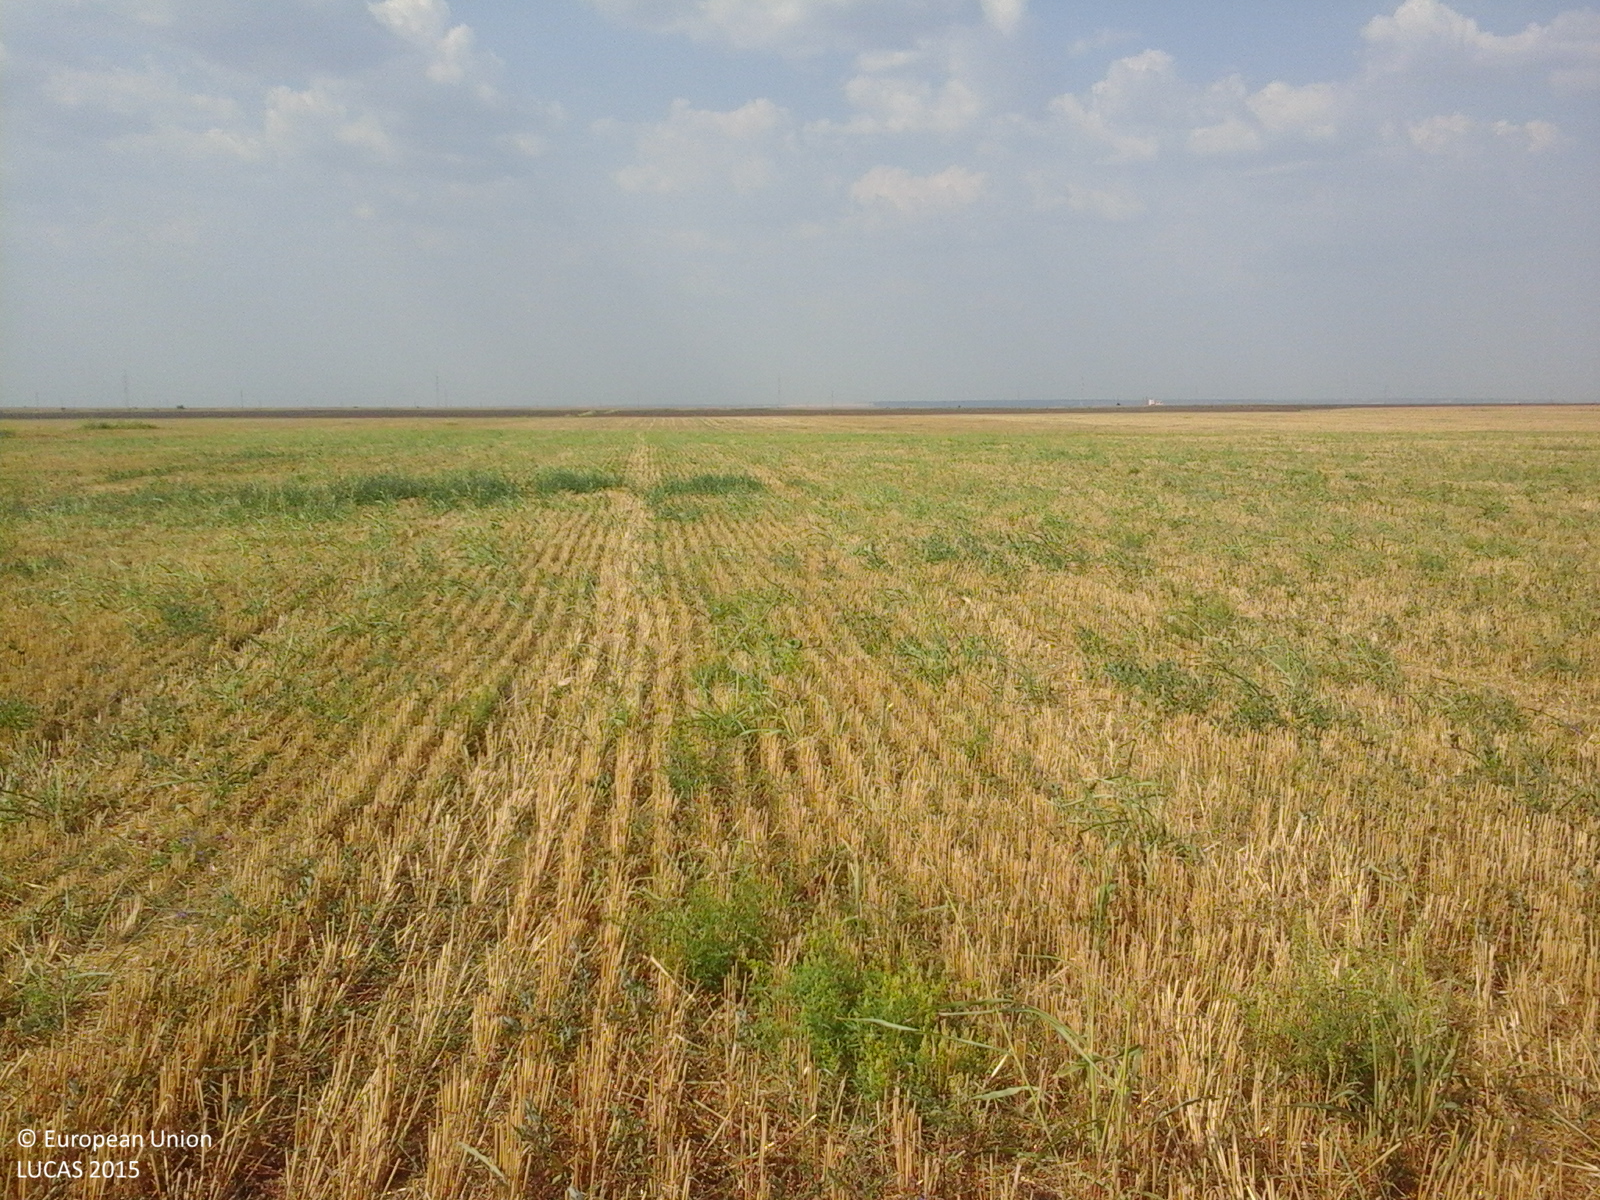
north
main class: Cropland
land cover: Common wheat
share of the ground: > 75 %
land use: Agriculture (excluding fallow land and kitchen gardens)
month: August
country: RO
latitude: 44.1004
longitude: 23.0978
